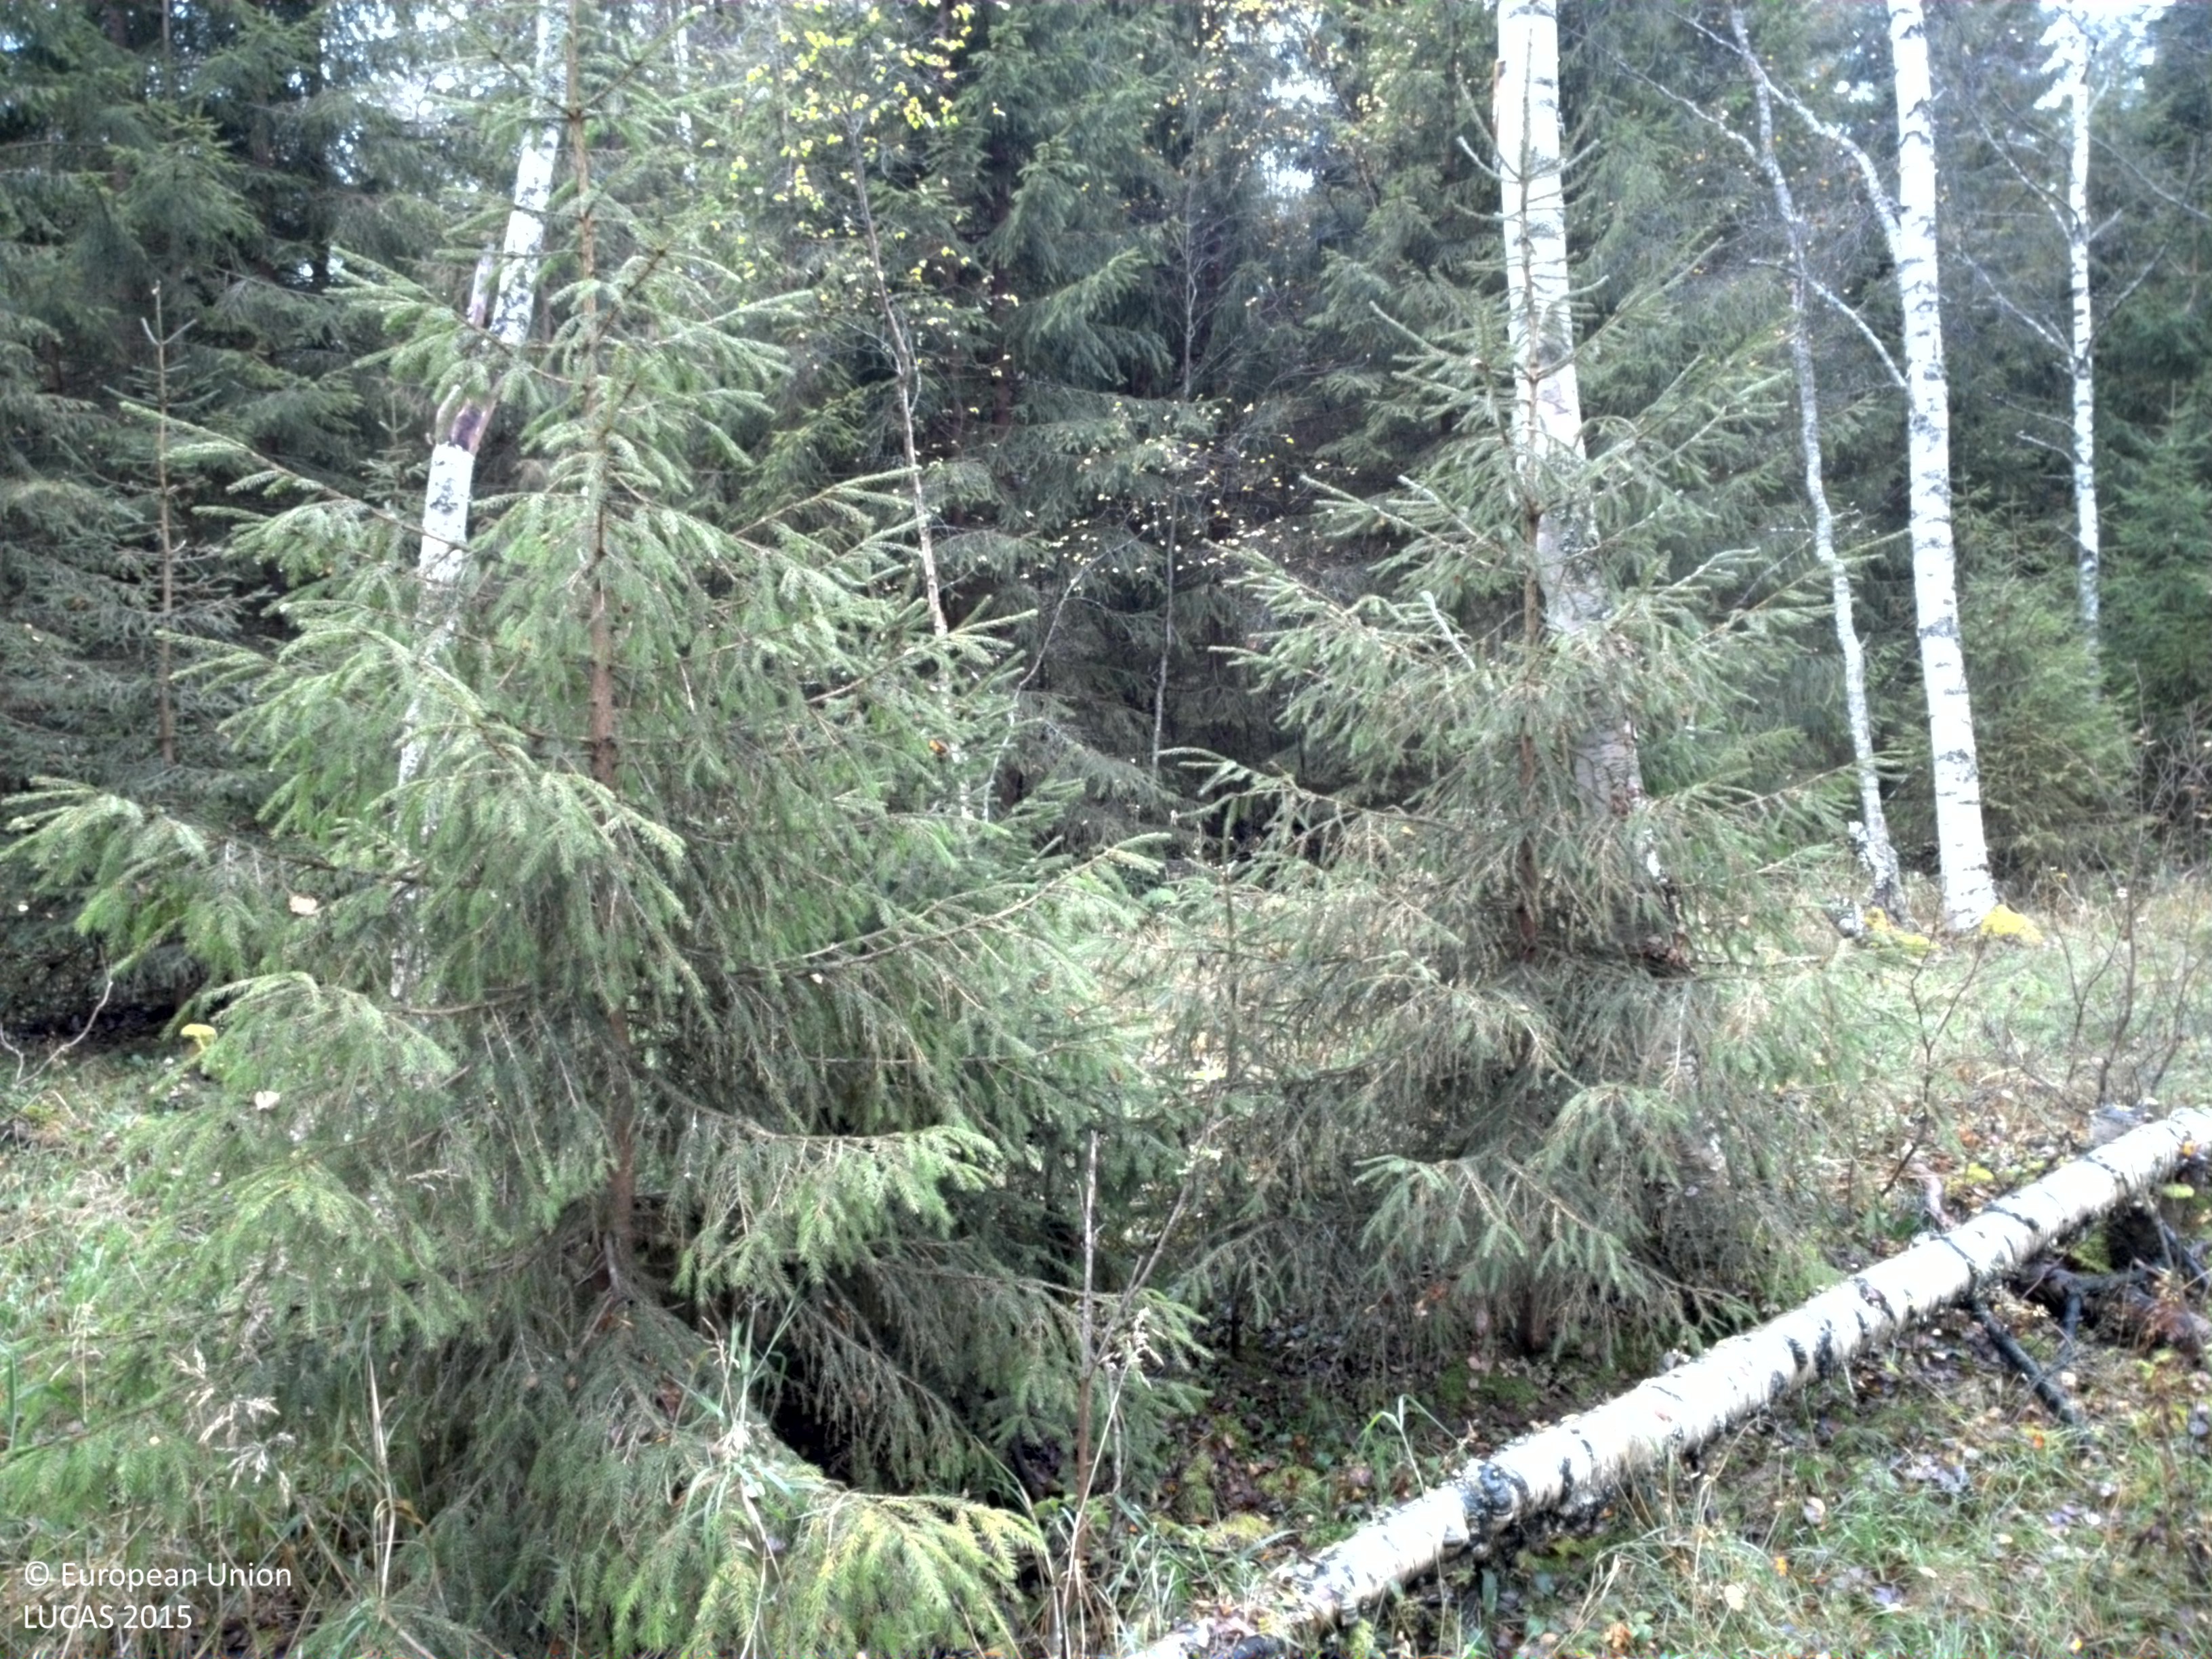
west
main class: Woodland
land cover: Broadleaved woodland
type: non-riverine alder, birch or aspen forest
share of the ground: 50 - 75 %
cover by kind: broadleaved forest trees 45 %, herbaceous plants 40 %, coniferous forest trees 10 %, shrubs 5 %
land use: Forestry
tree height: > 5 m
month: September
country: SE
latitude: 65.6633
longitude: 22.0033
